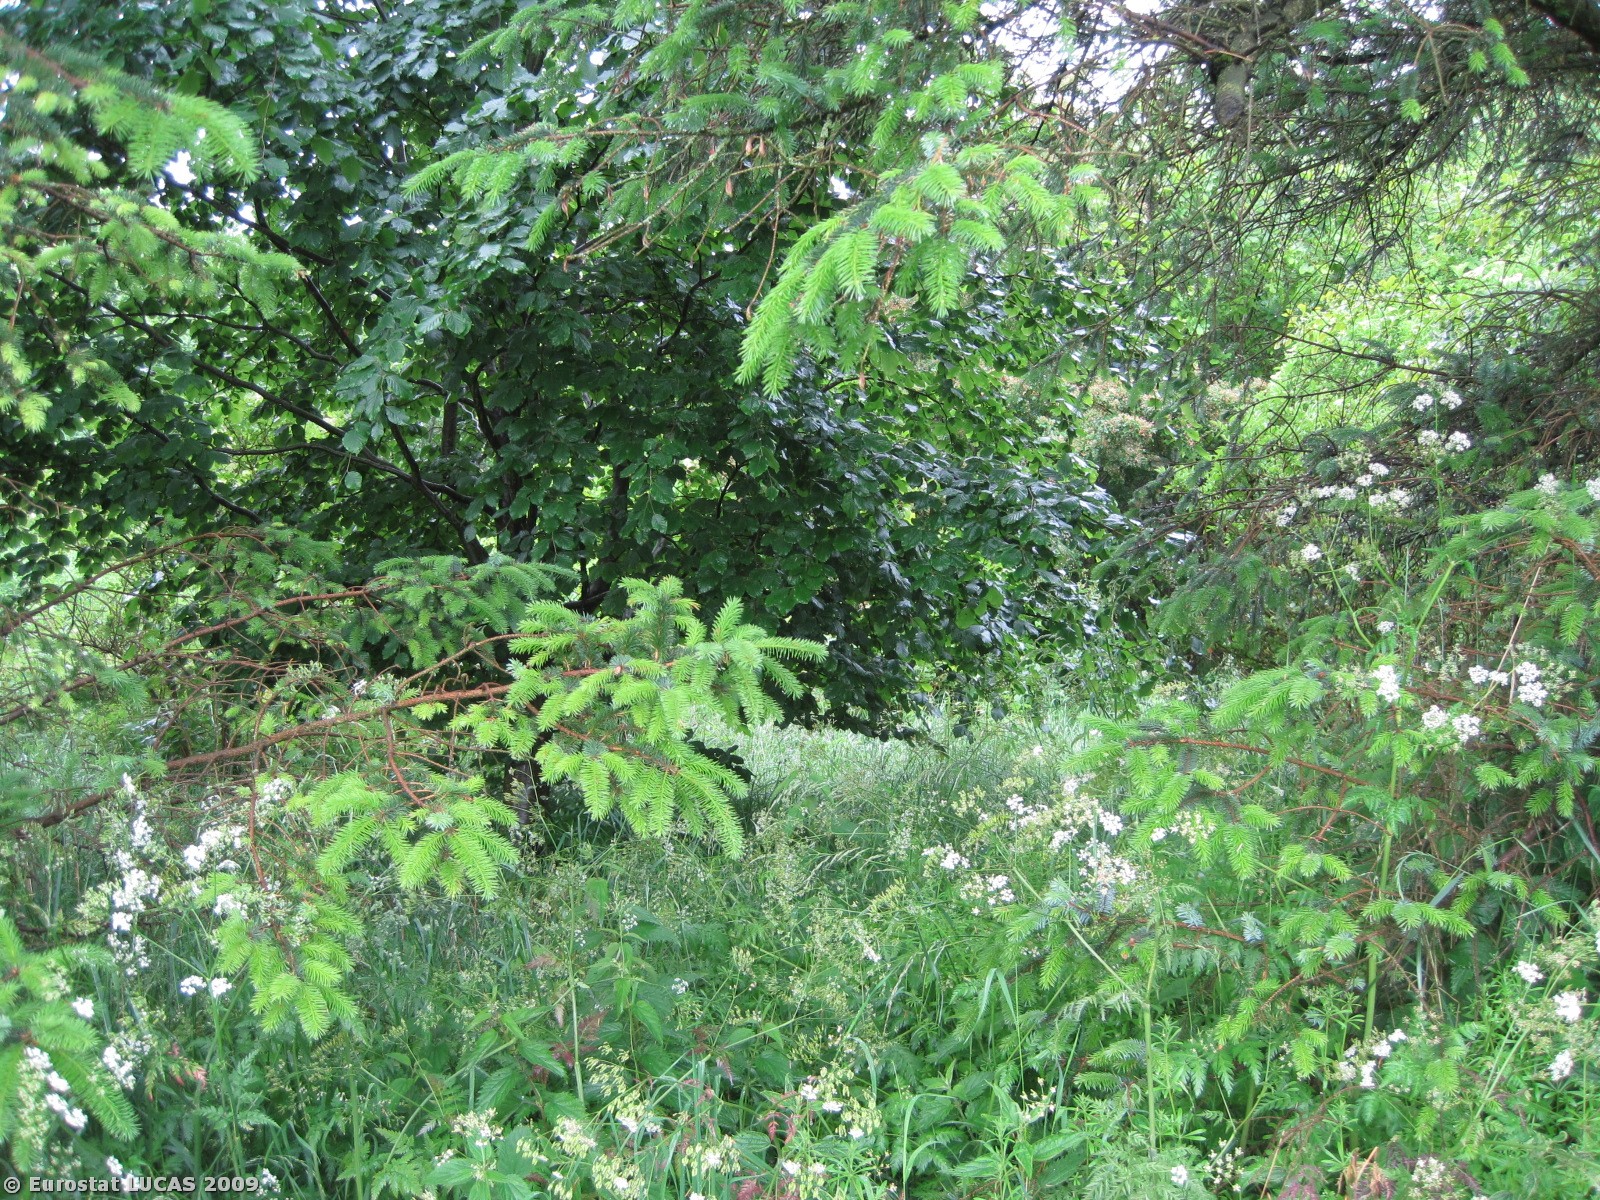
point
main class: Woodland
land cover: Mixed woodland
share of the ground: > 75 %
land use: Unused
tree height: > 5 m
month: June
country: DK
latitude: 57.5179
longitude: 10.2500
